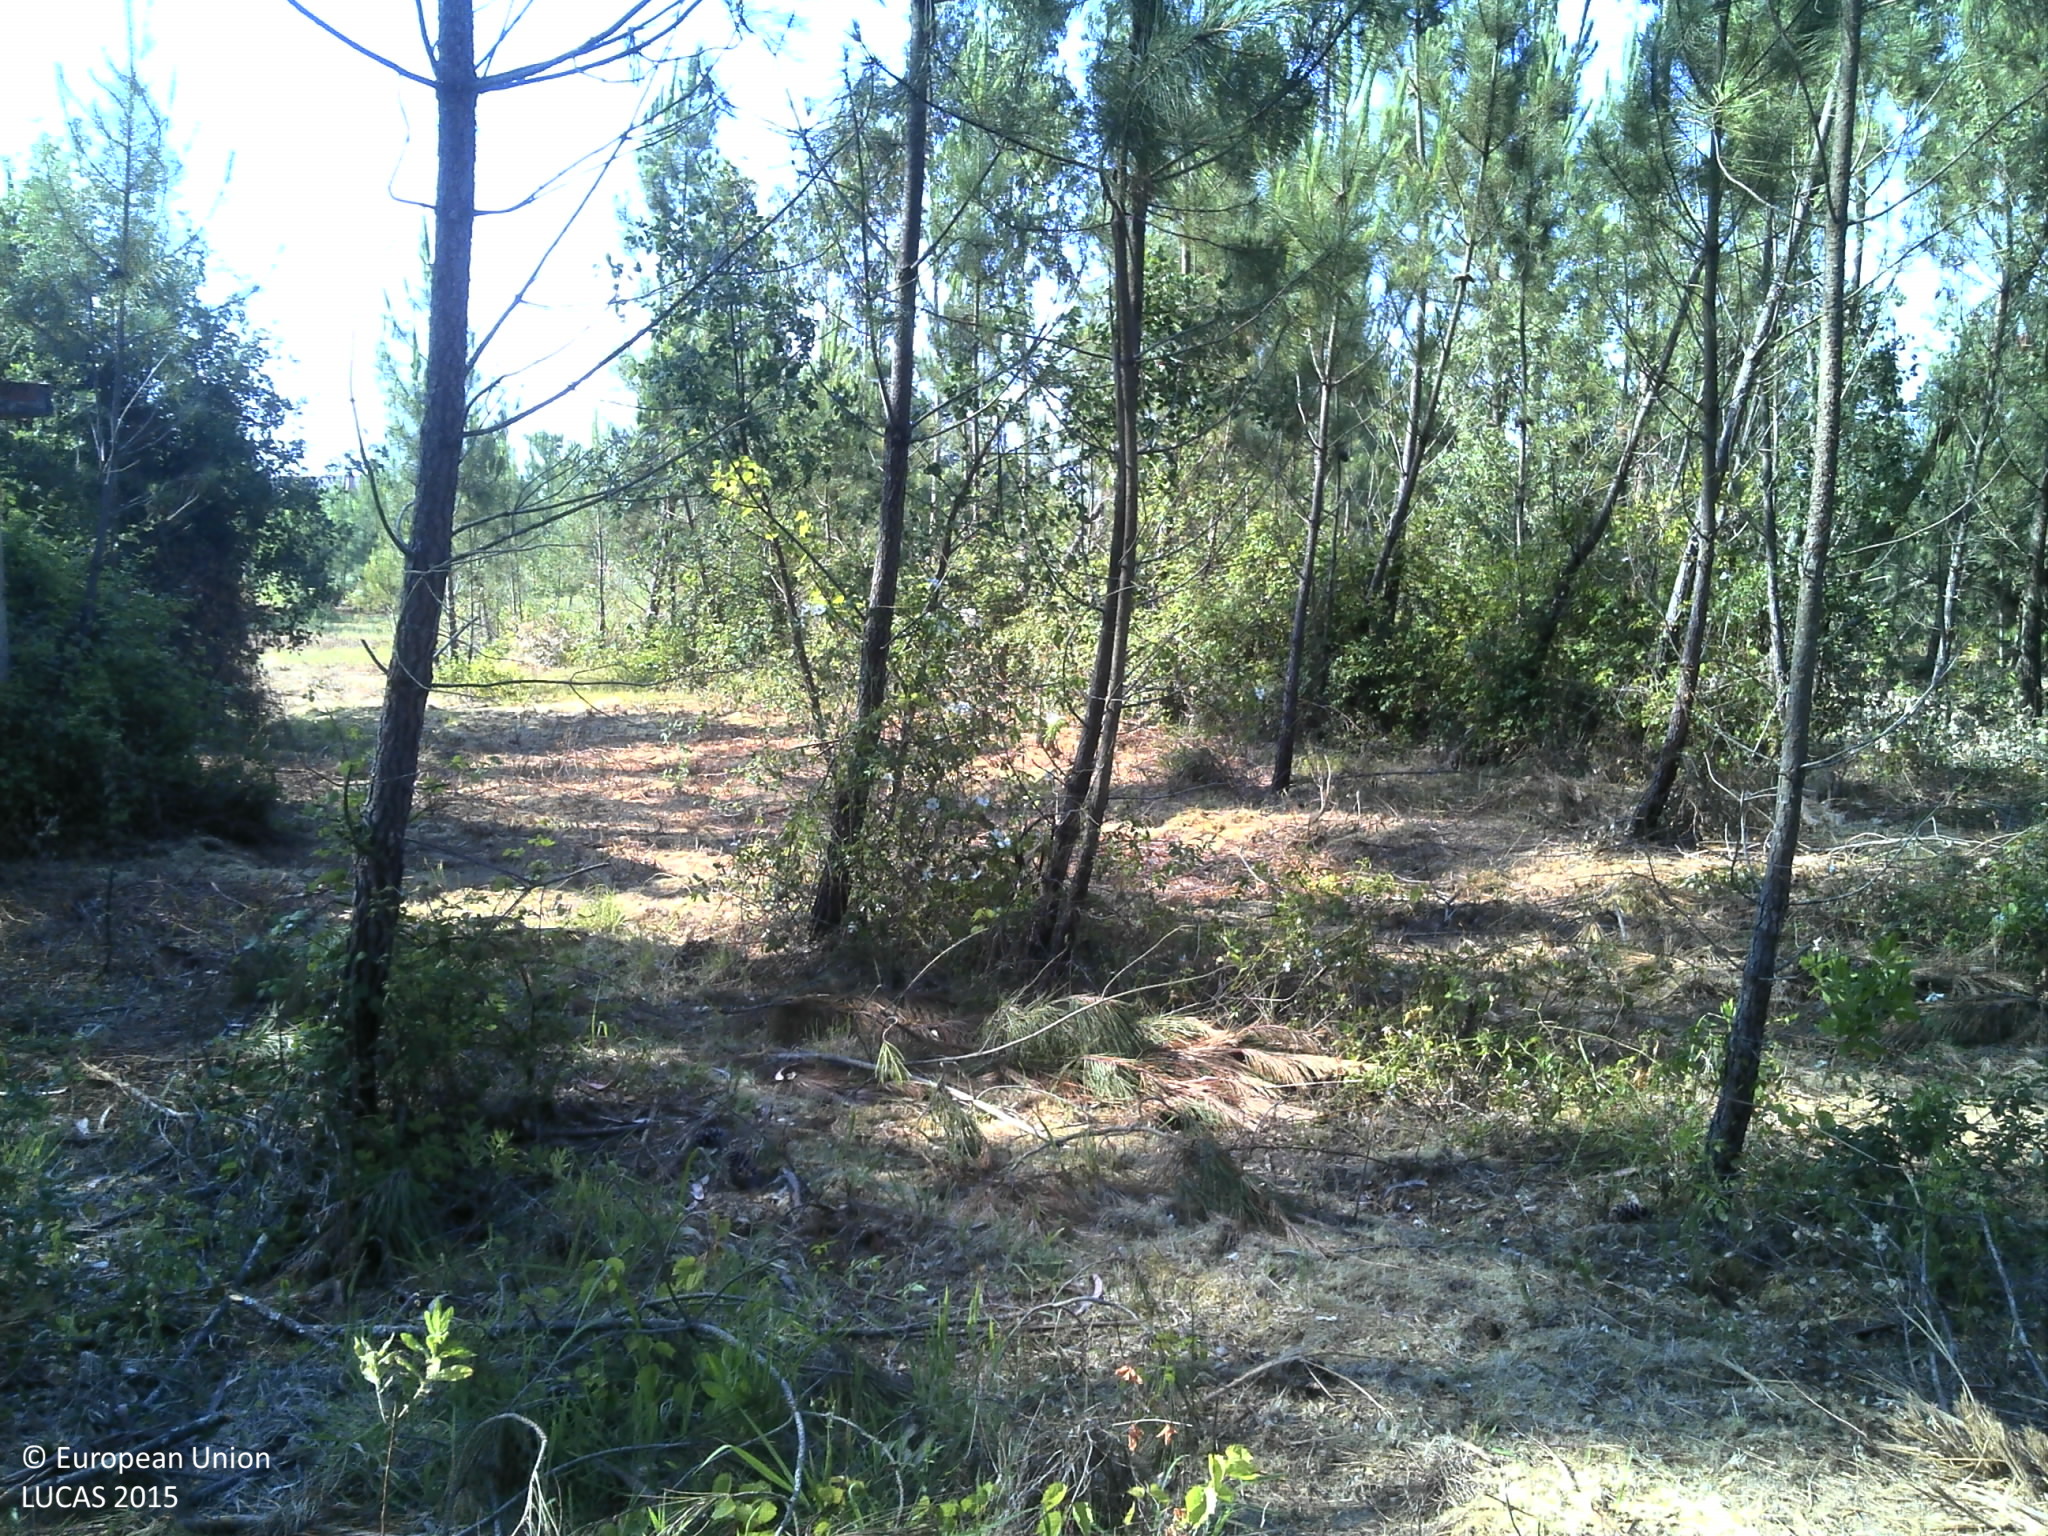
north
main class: Woodland
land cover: Pine dominated coniferous woodland
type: coniferous forest of the mediterranean region
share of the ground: 25 - 50 %
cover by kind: coniferous forest trees 50 %, shrubs 25 %, unconsolidated bare surface 25 %
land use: Forestry
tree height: < 5 m
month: June
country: PT
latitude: 40.3120
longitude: -8.6482
